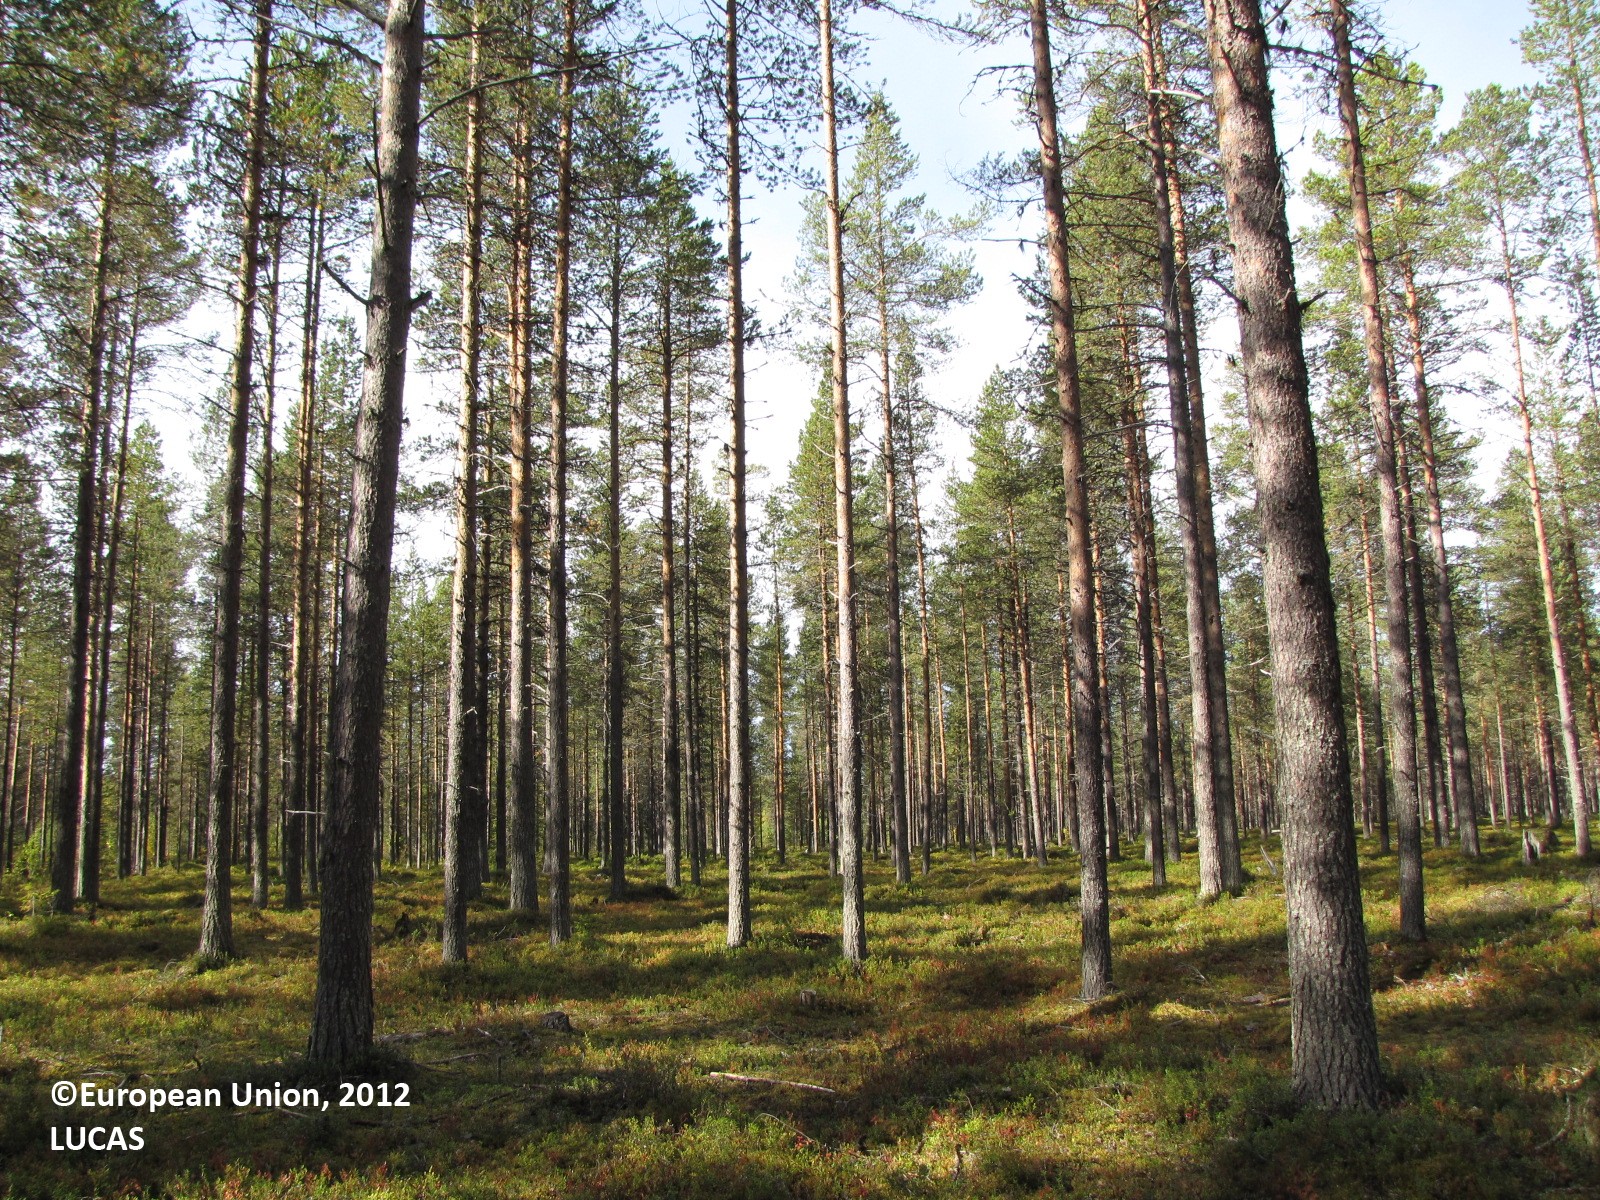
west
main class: Woodland
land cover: Pine dominated coniferous woodland
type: boreal forest
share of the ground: 50 - 75 %
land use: Forestry
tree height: > 5 m
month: September
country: FI
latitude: 67.1340
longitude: 24.8241
